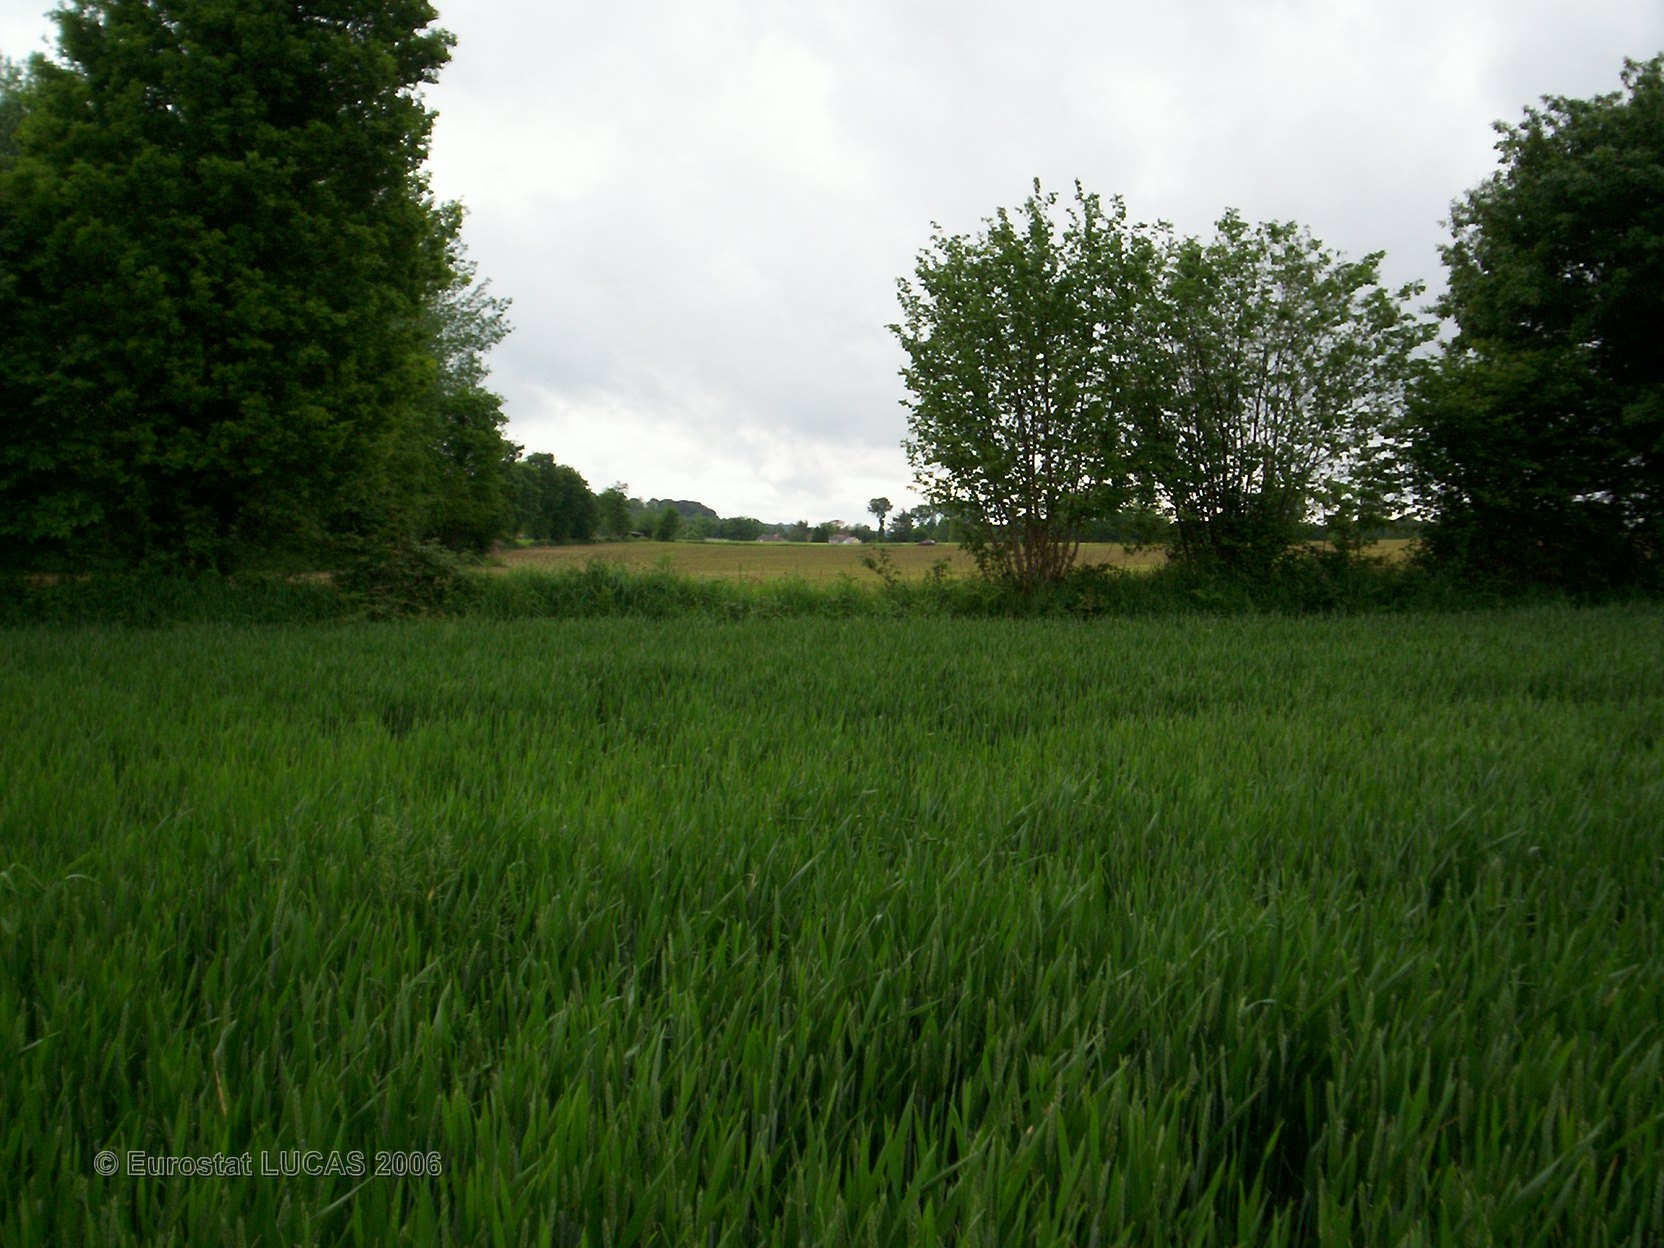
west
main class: Cropland
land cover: Common wheat
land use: Agriculture (excluding fallow land and kitchen gardens)
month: May
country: FR
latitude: 48.2090
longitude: -2.4263
